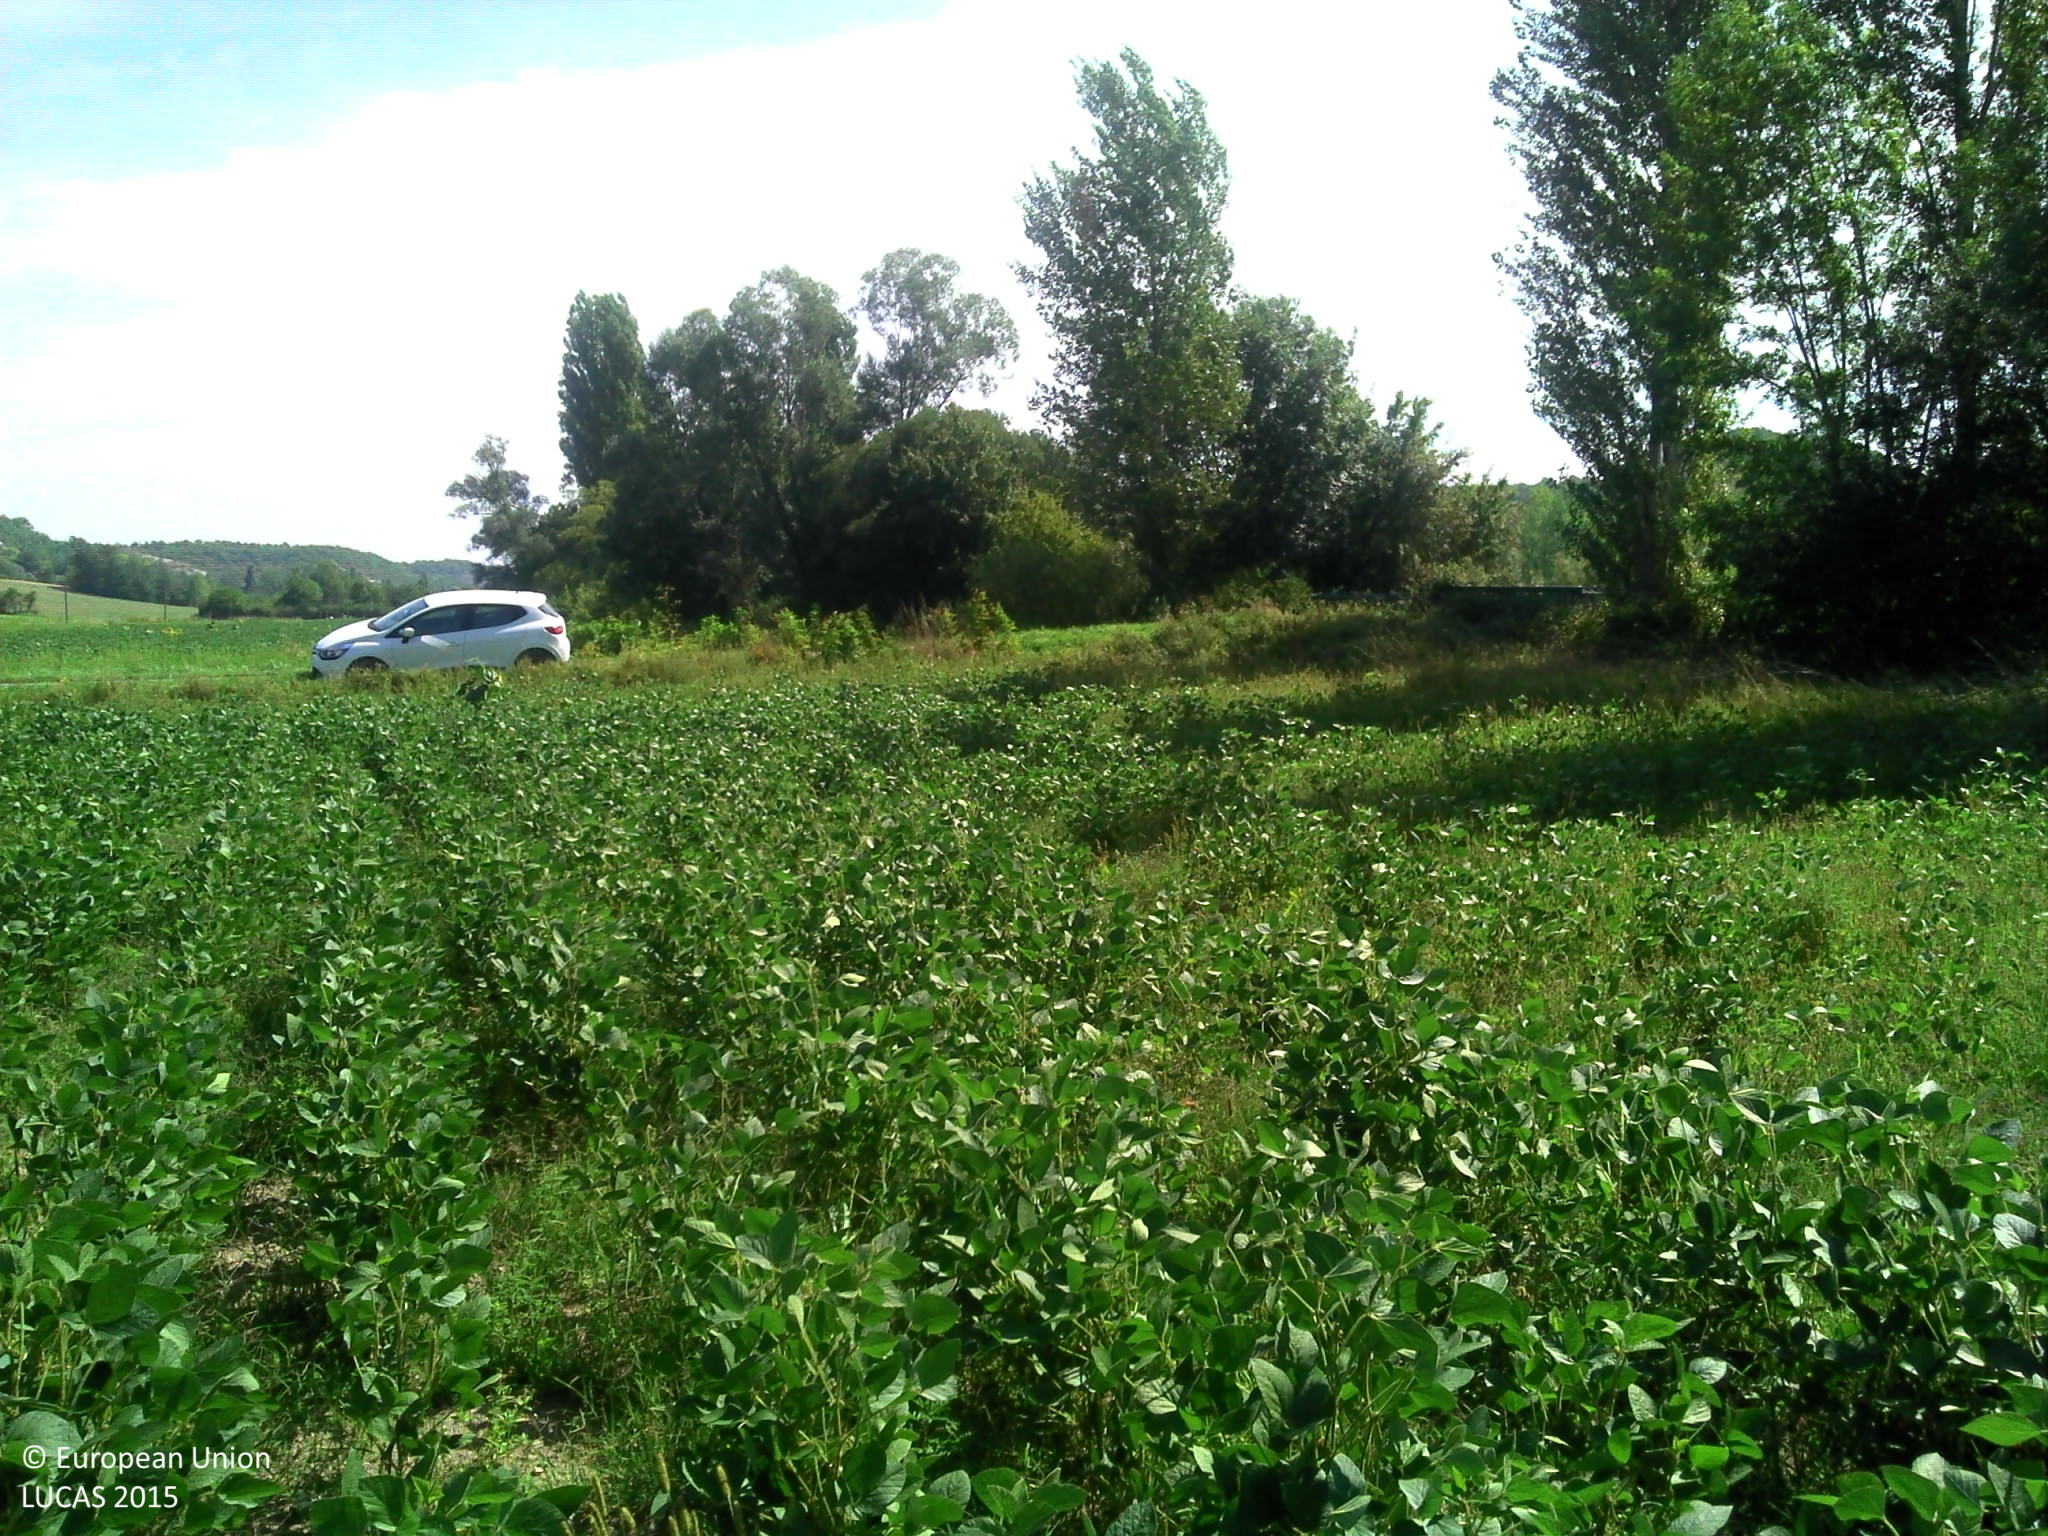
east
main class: Cropland
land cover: Soya
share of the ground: > 75 %
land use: Agriculture (excluding fallow land and kitchen gardens)
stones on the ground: < 10 %
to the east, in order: Soya; Grass margins; Paved roads, cycling and walking lanes; Grass margins; Soya; Abandoned hedges; Rivers and streams; Abandoned hedges; Grassland without tree/shrub cover; Maize; Other bare soil
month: August
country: FR
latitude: 44.3613
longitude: 1.2521
